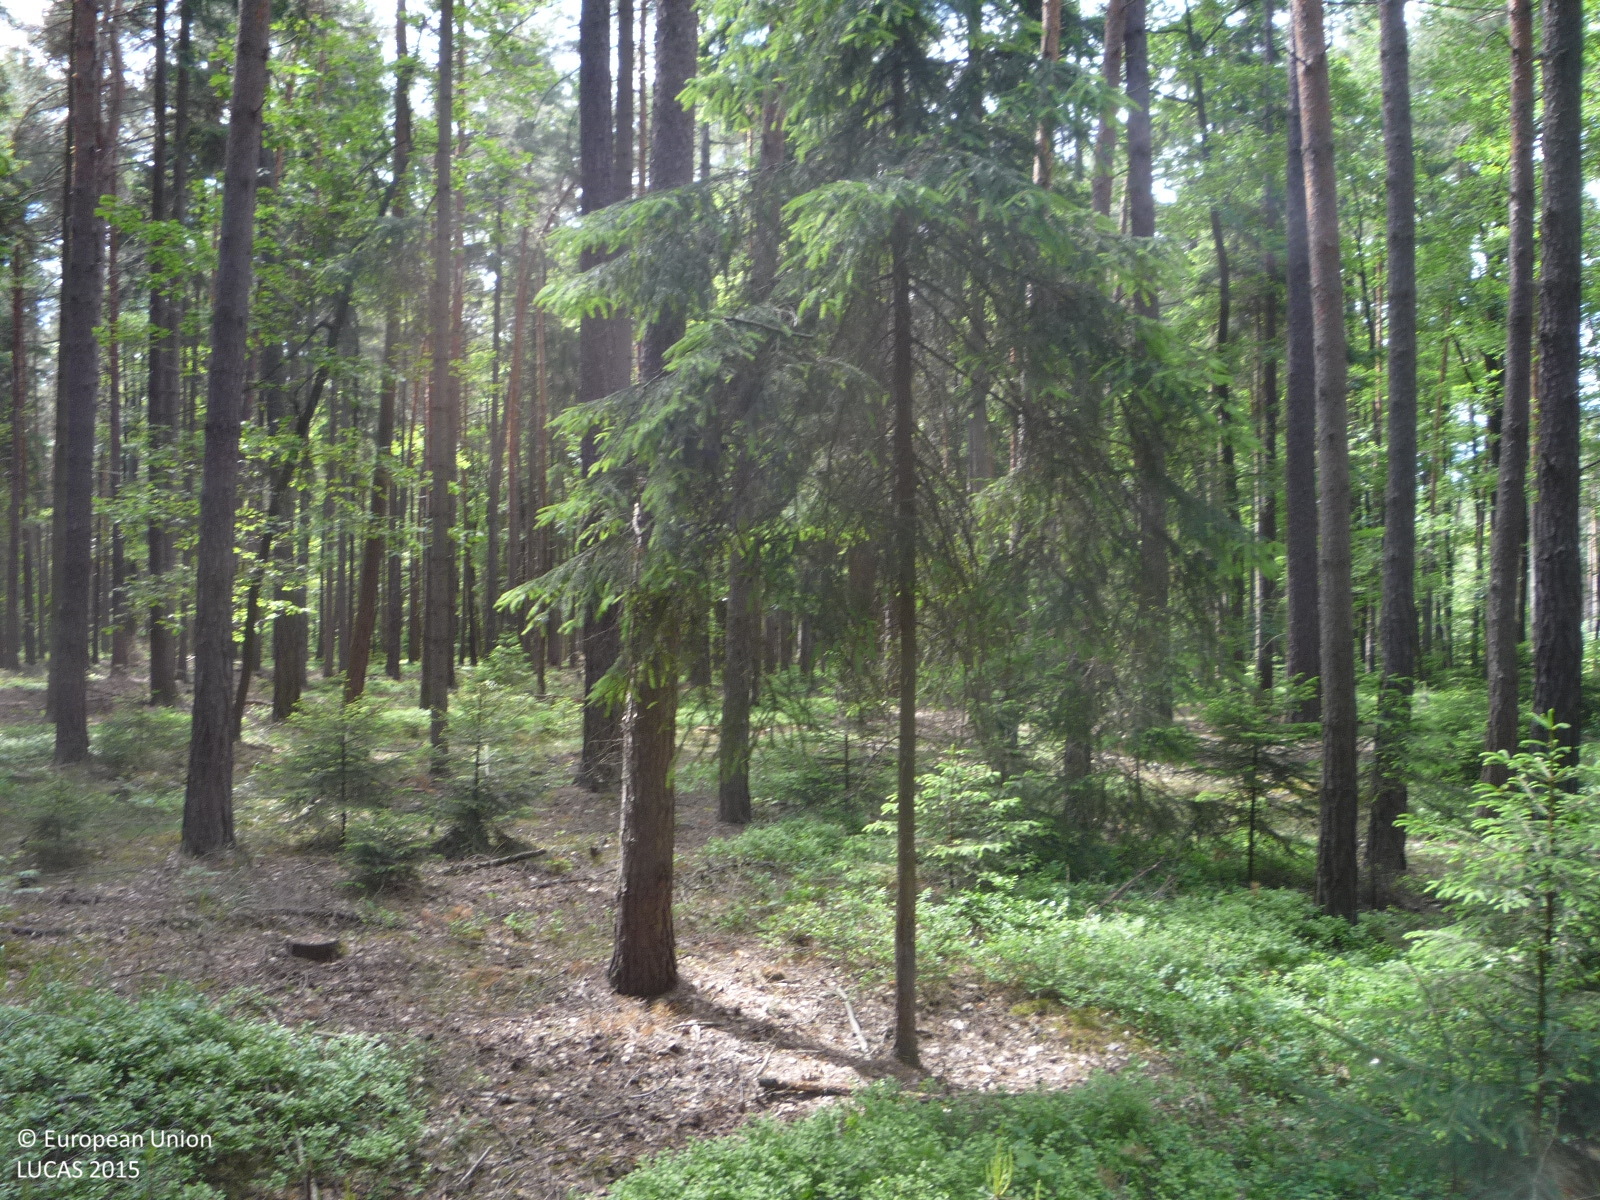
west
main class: Woodland
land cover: Pine dominated coniferous woodland
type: hemiboreal forest and nemoral coniferous forest and mixed broadleaved-coniferous forest
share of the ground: > 75 %
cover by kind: coniferous forest trees 90 %, broadleaved forest trees 10 %
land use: Forestry
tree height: > 5 m
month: June
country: CZ
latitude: 50.2450
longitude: 13.8570
